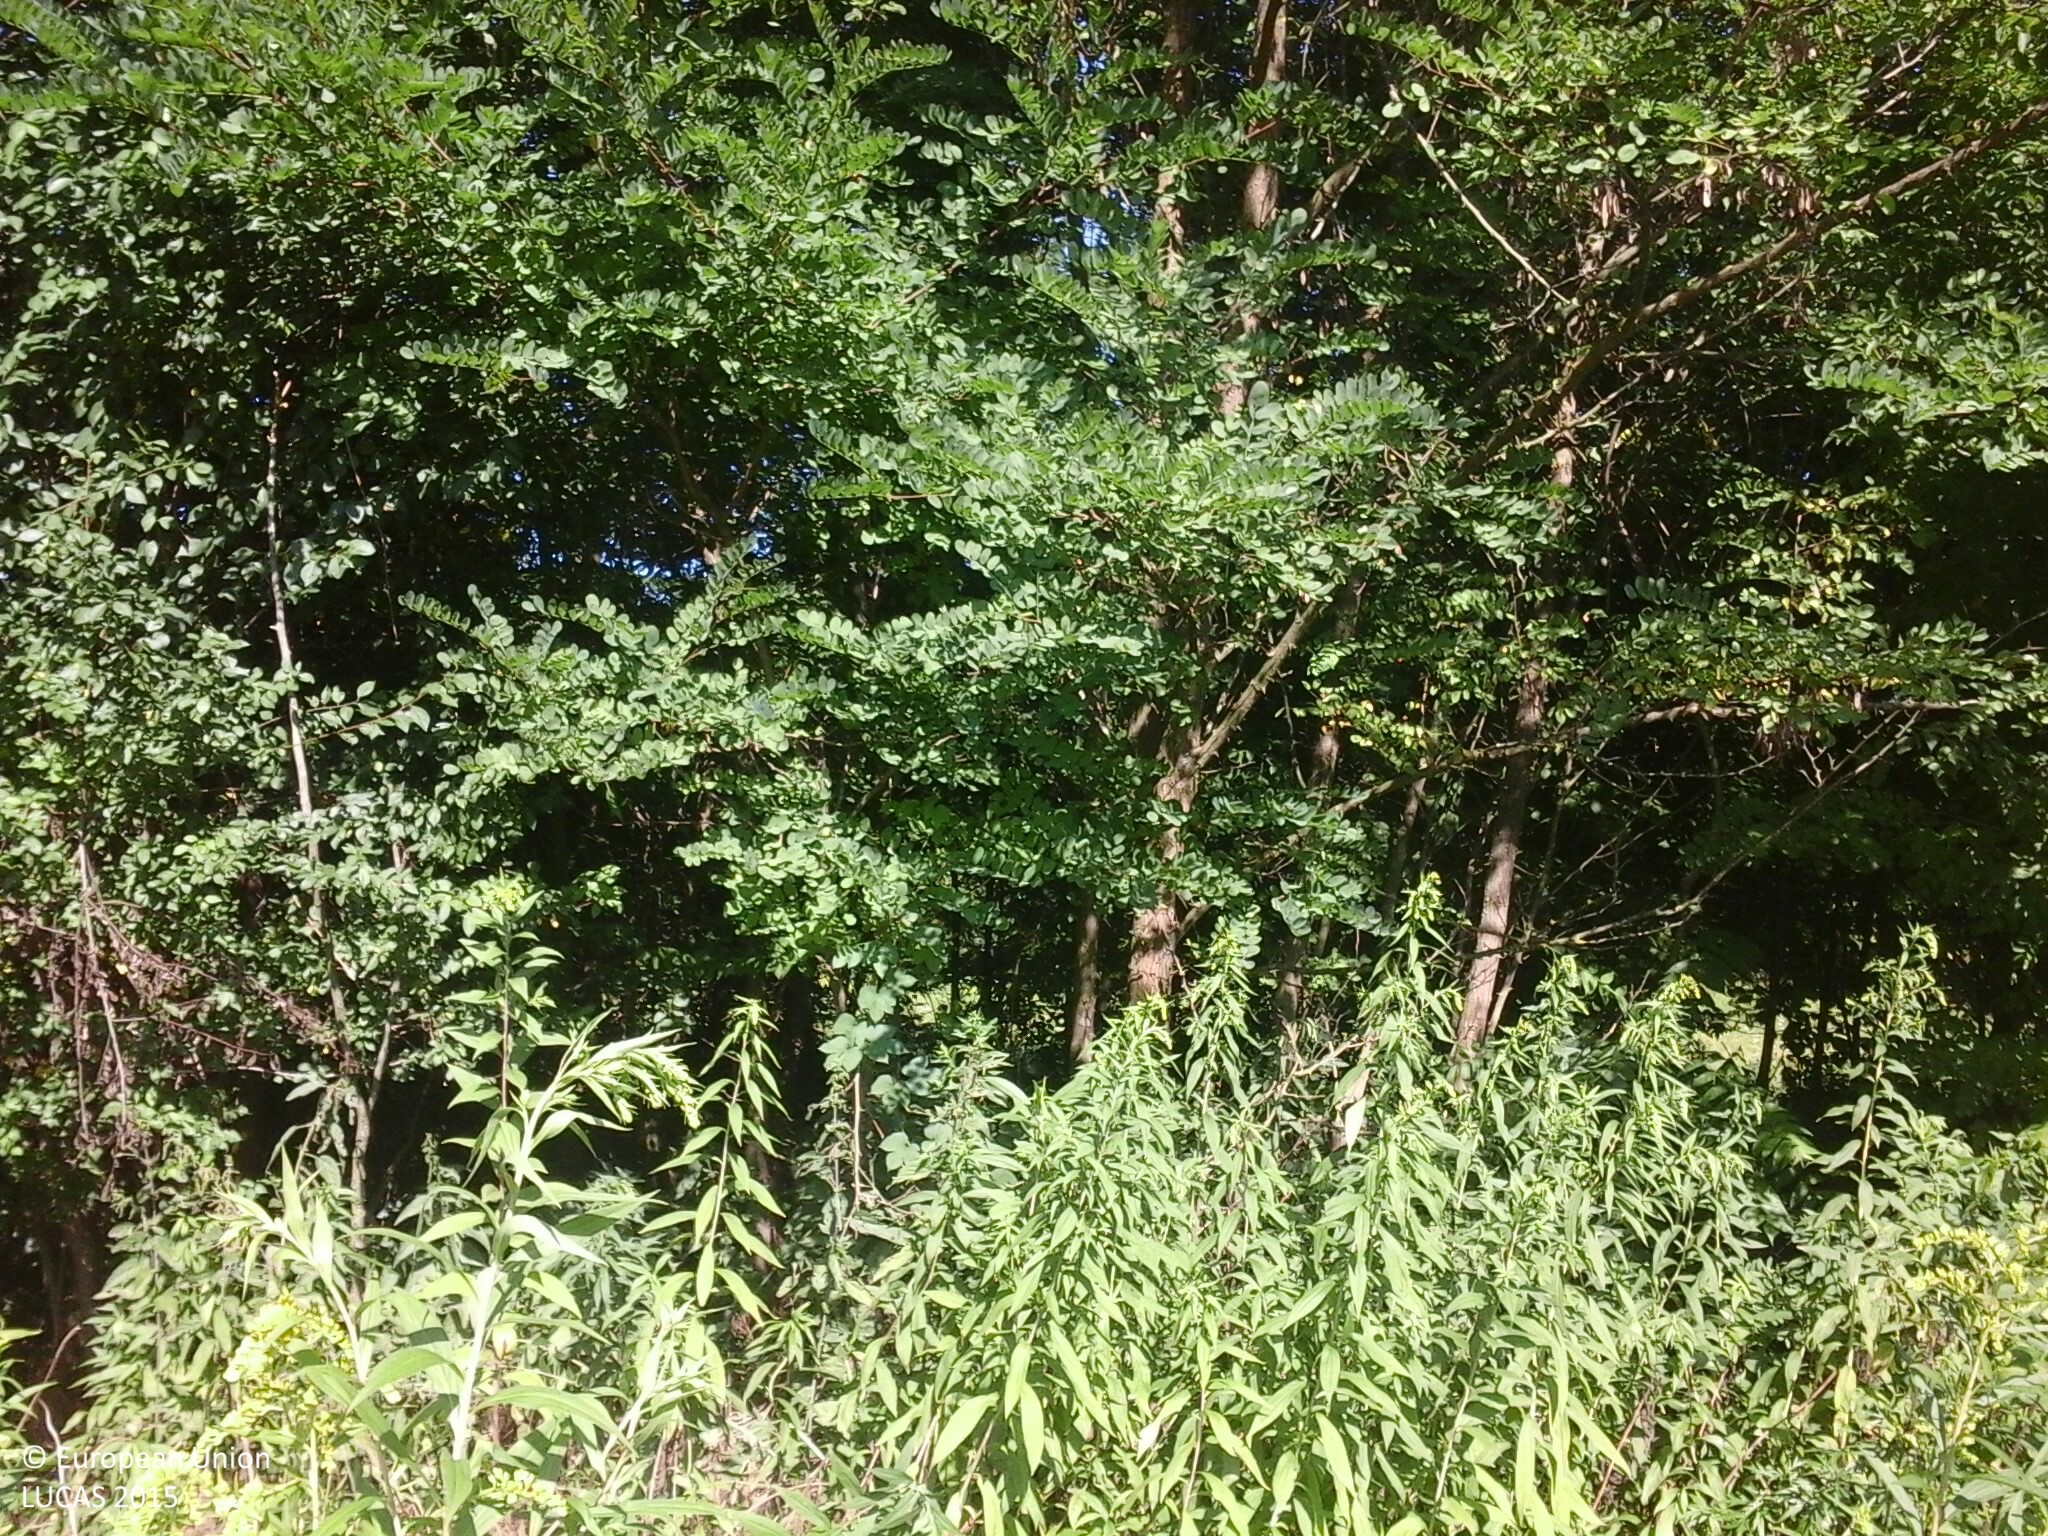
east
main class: Woodland
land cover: Broadleaved woodland
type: mesophytic deciduous forest
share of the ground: > 75 %
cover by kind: broadleaved forest trees 70 %, shrubs 20 %, herbaceous plants 10 %
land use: Forestry
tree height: < 5 m
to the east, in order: Broadleaved woodland; Grassland without tree/shrub cover; Fences; Broadleaved woodland; Grass margins; Tracks; Spontaneously vegetated surfaces; Spruce dominated coniferous woodland
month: July
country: HU
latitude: 46.6699
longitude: 17.7053
